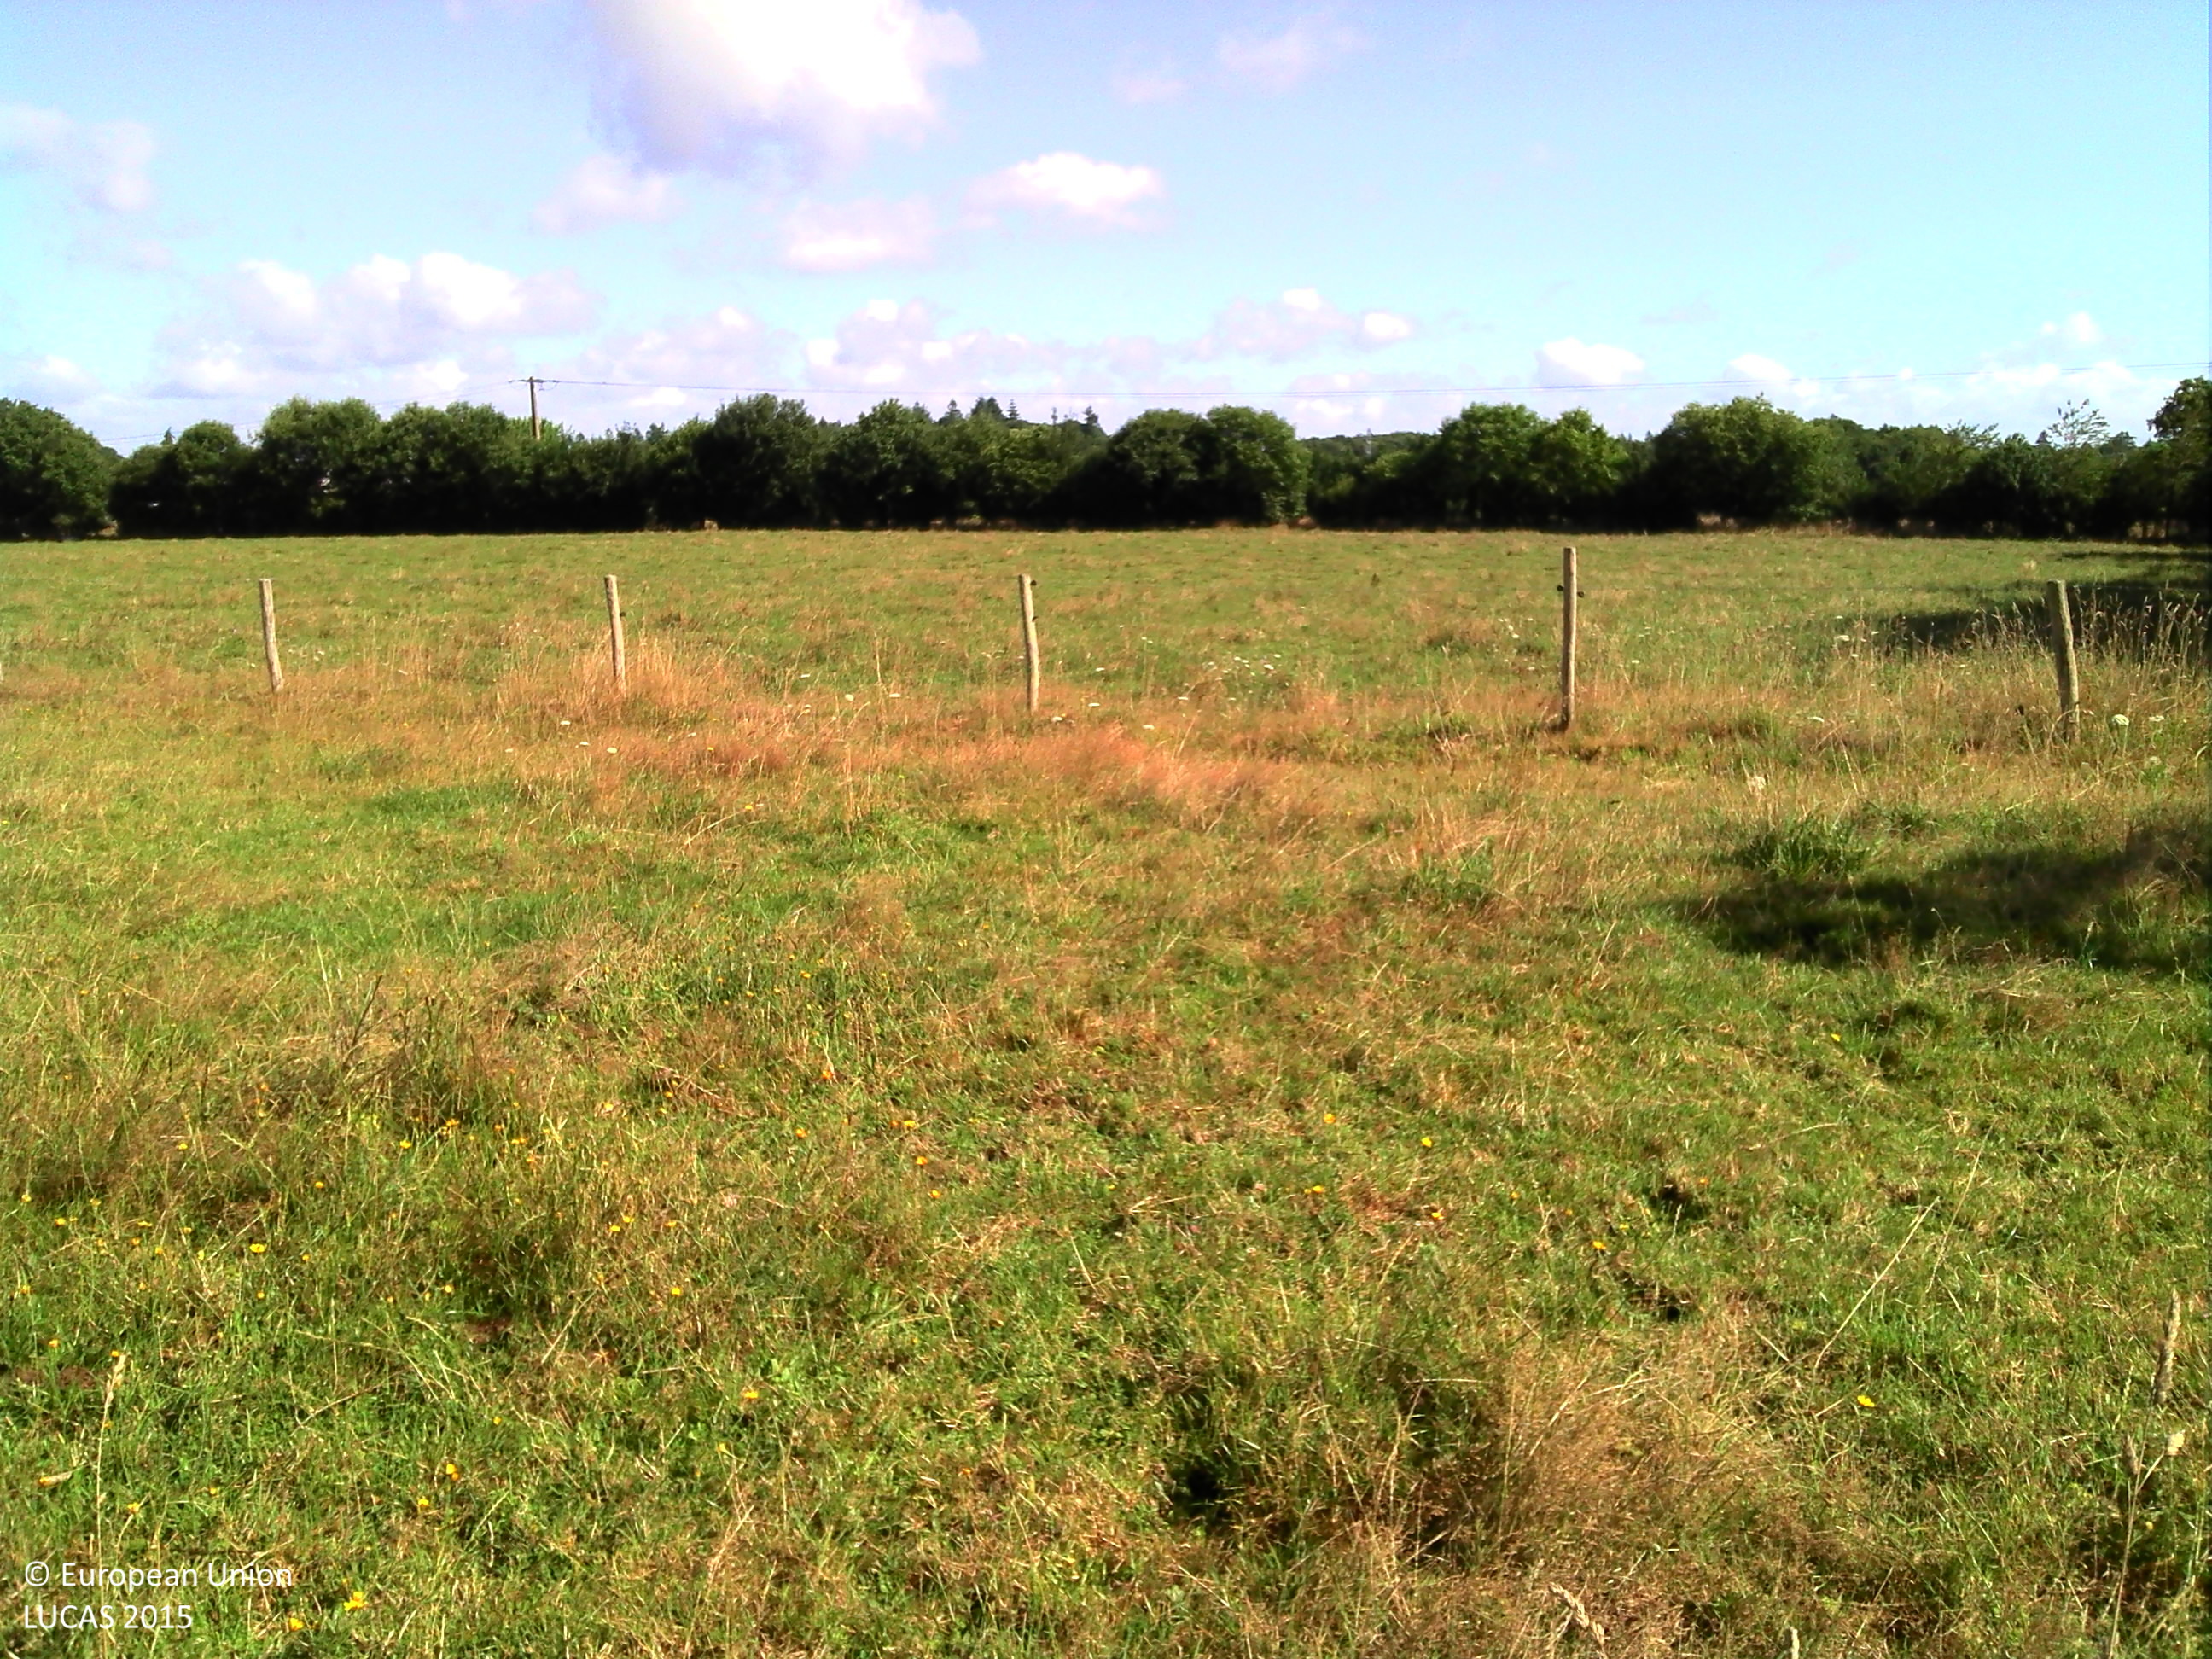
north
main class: Grassland
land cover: Grassland without tree/shrub cover
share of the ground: > 75 %
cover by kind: herbaceous plants 80 %, consolidated bare surface 20 %
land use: Agriculture (excluding fallow land and kitchen gardens)
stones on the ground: 10 - 25 %
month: July
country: FR
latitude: 47.6814
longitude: -2.8924
